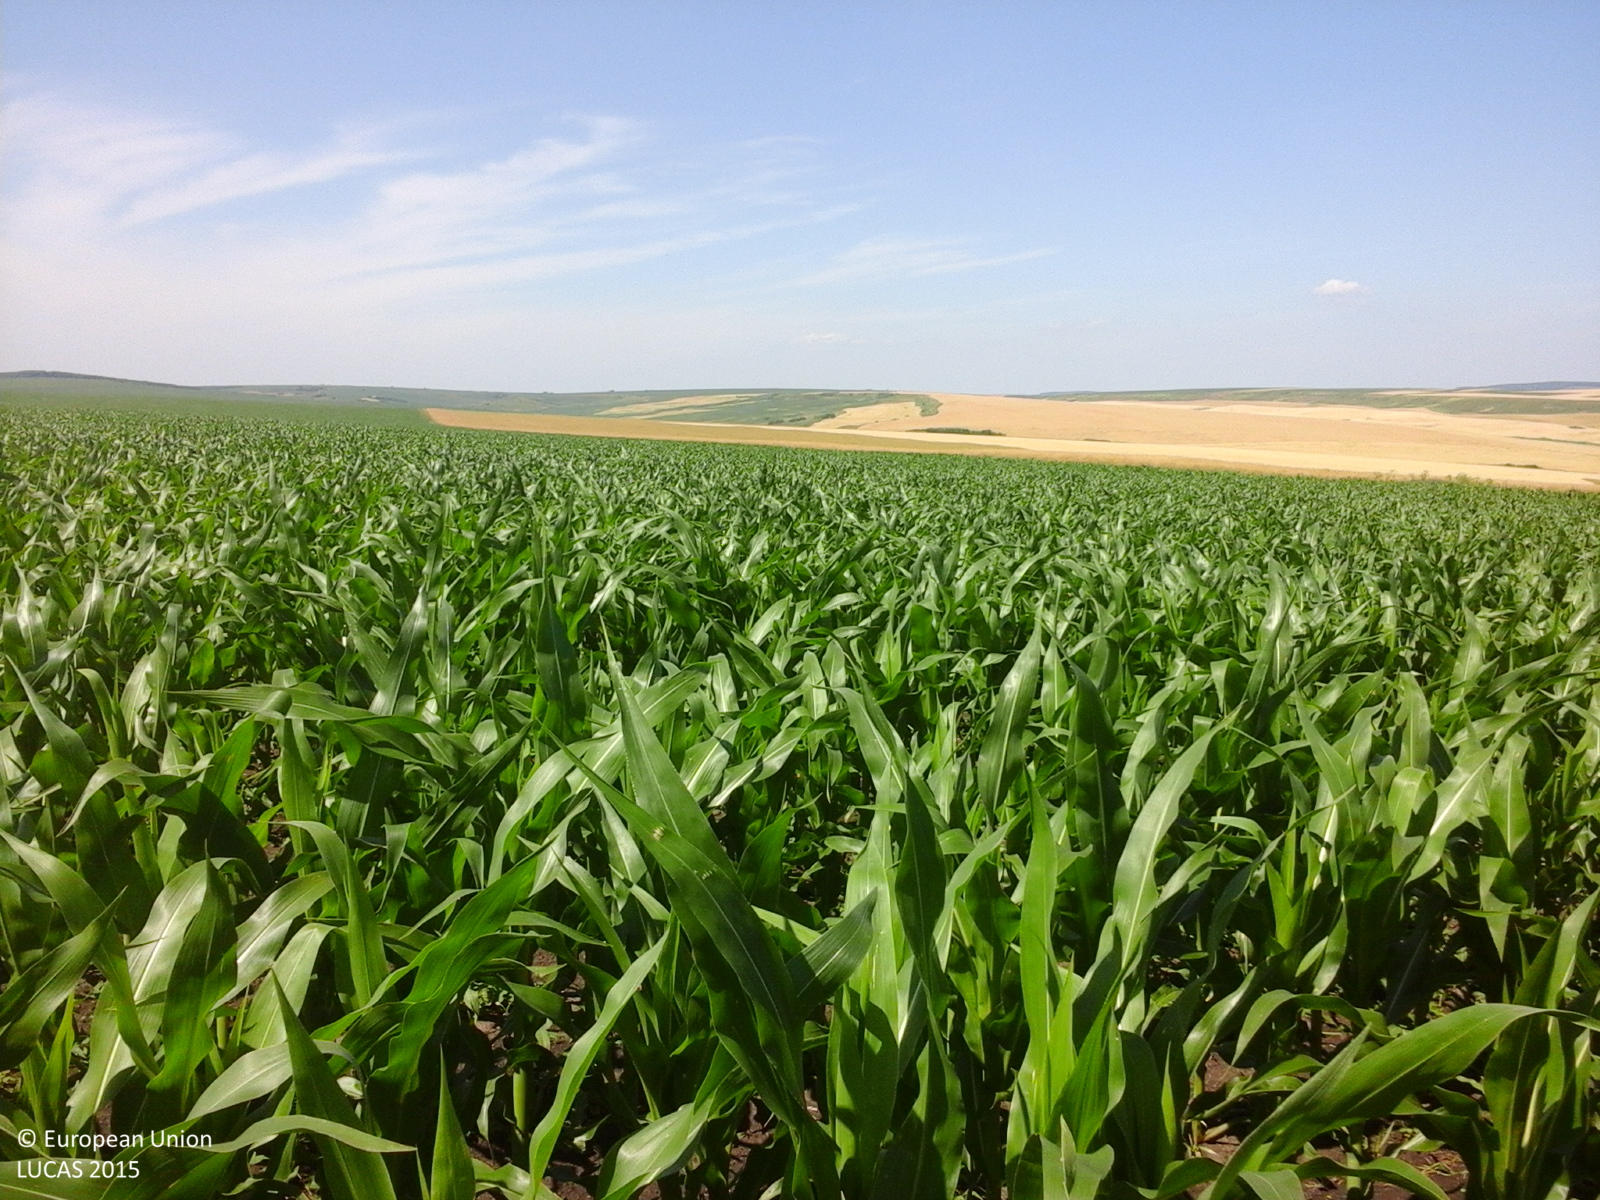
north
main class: Cropland
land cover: Maize
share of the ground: > 75 %
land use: Agriculture (excluding fallow land and kitchen gardens)
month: June
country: RO
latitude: 47.5284
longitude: 27.1490
